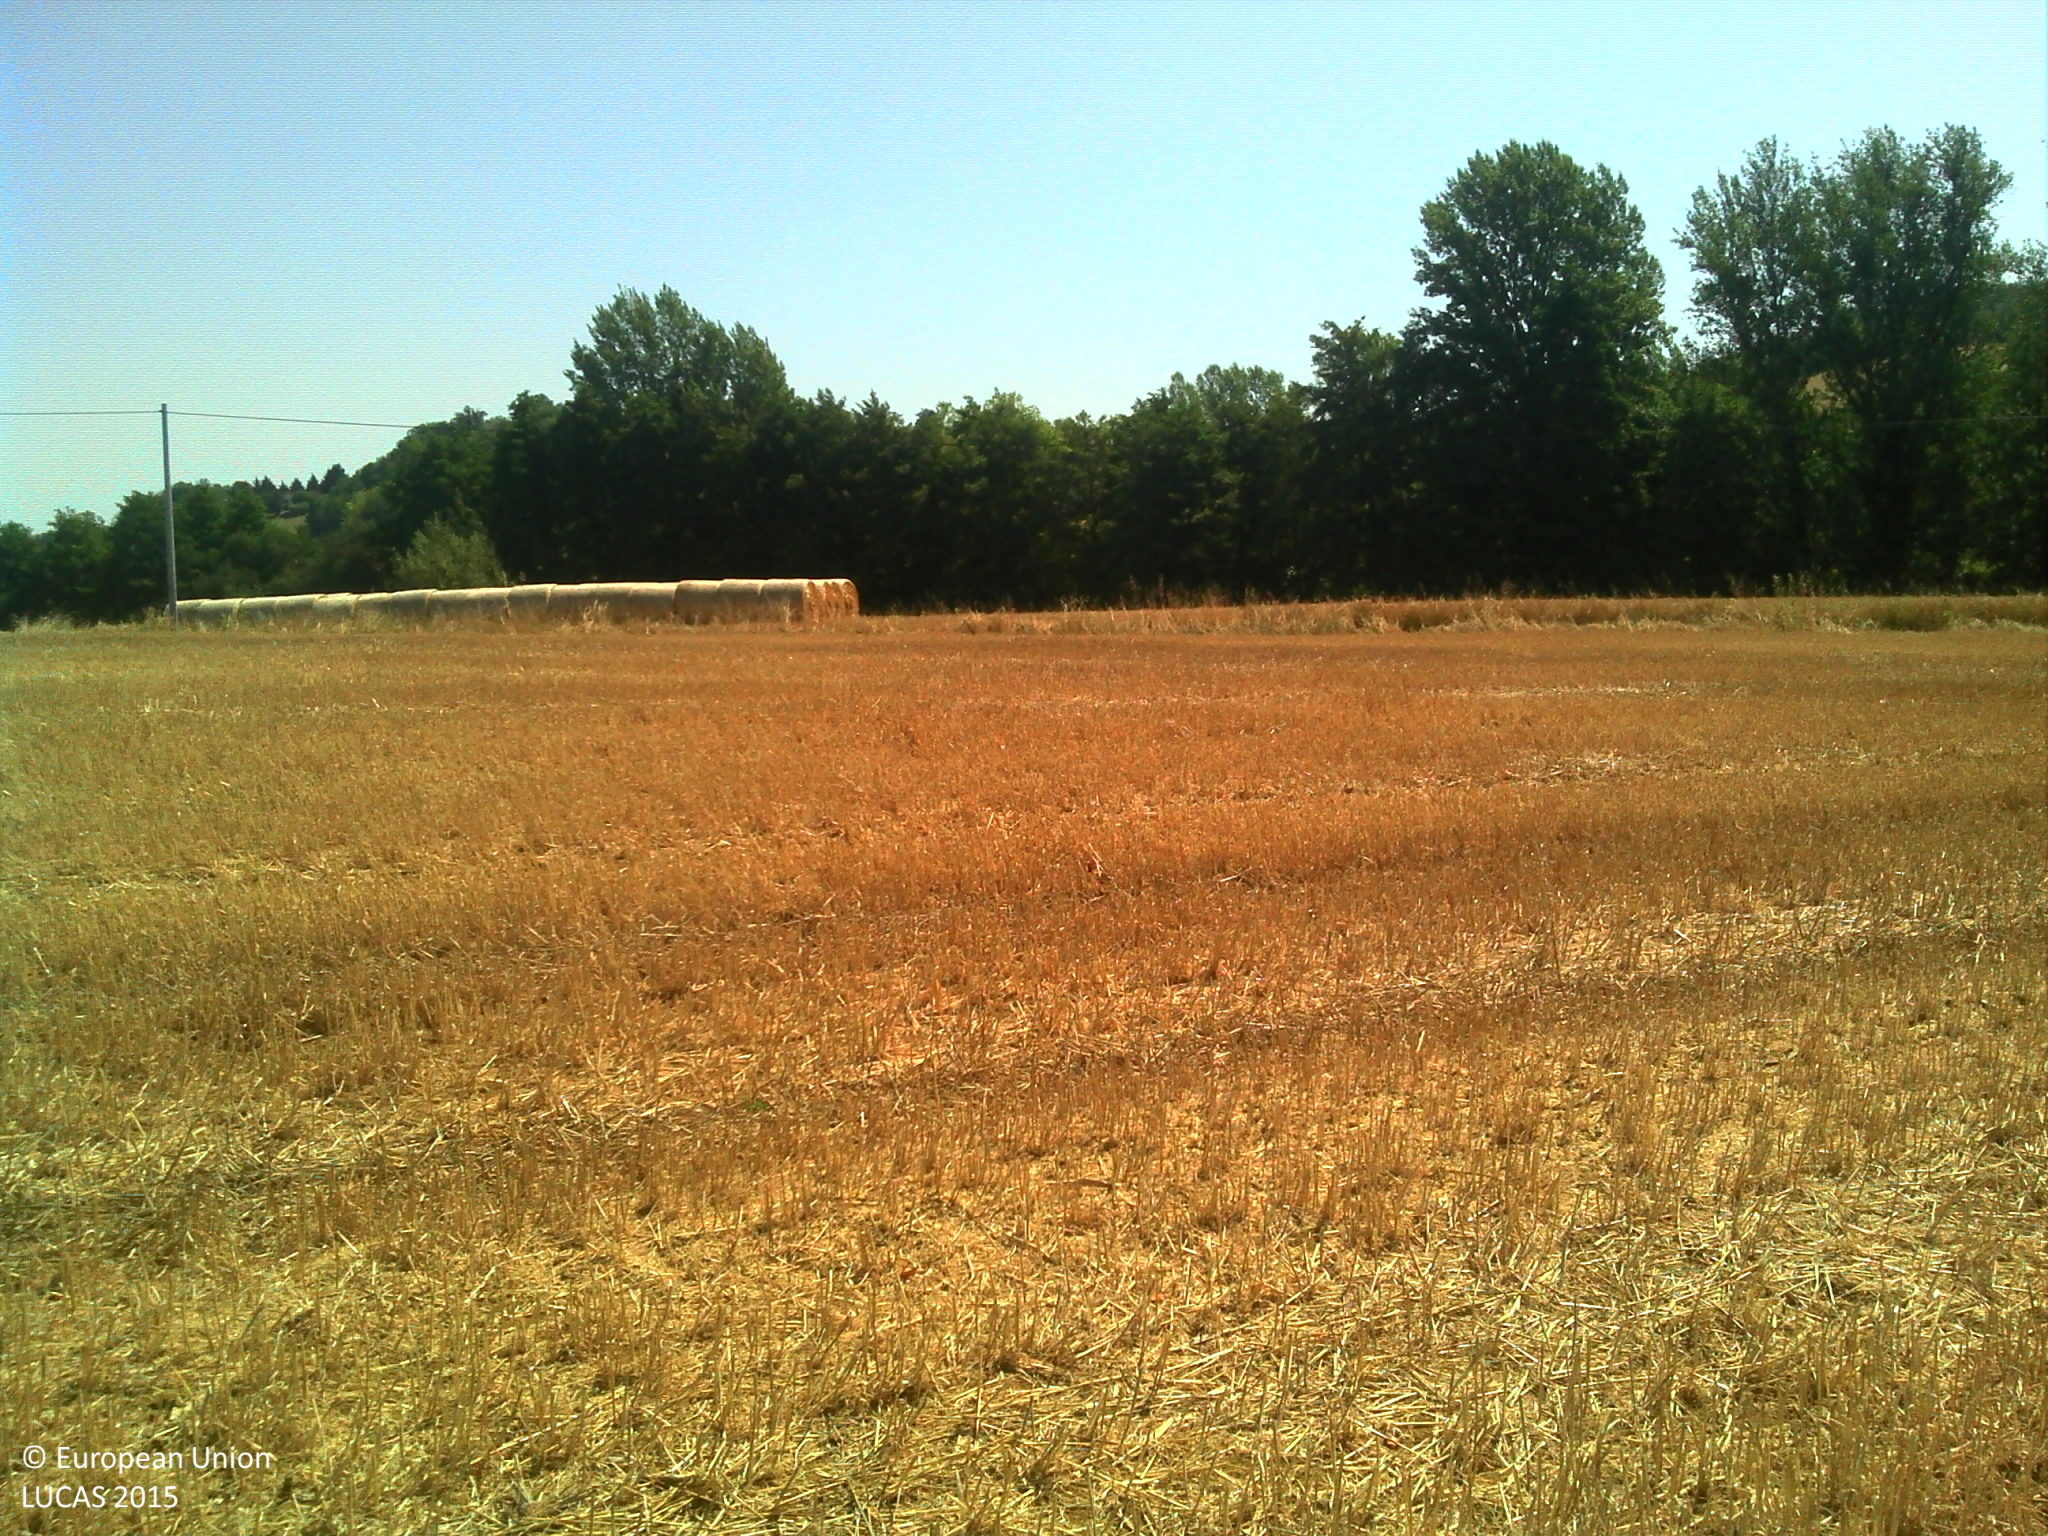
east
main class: Cropland
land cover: Common wheat
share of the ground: > 75 %
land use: Agriculture (excluding fallow land and kitchen gardens)
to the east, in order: Common wheat; Electric lines; Ditches and canals; Grass margins; Paved roads, cycling and walking lanes; Grass margins; Ditches and canals; Common wheat; Broadleaved woodland; Rivers and streams; Broadleaved woodland; Common wheat; Ditches and canals; Broadleaved woodland
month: August
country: FR
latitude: 44.1960
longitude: 1.2273
